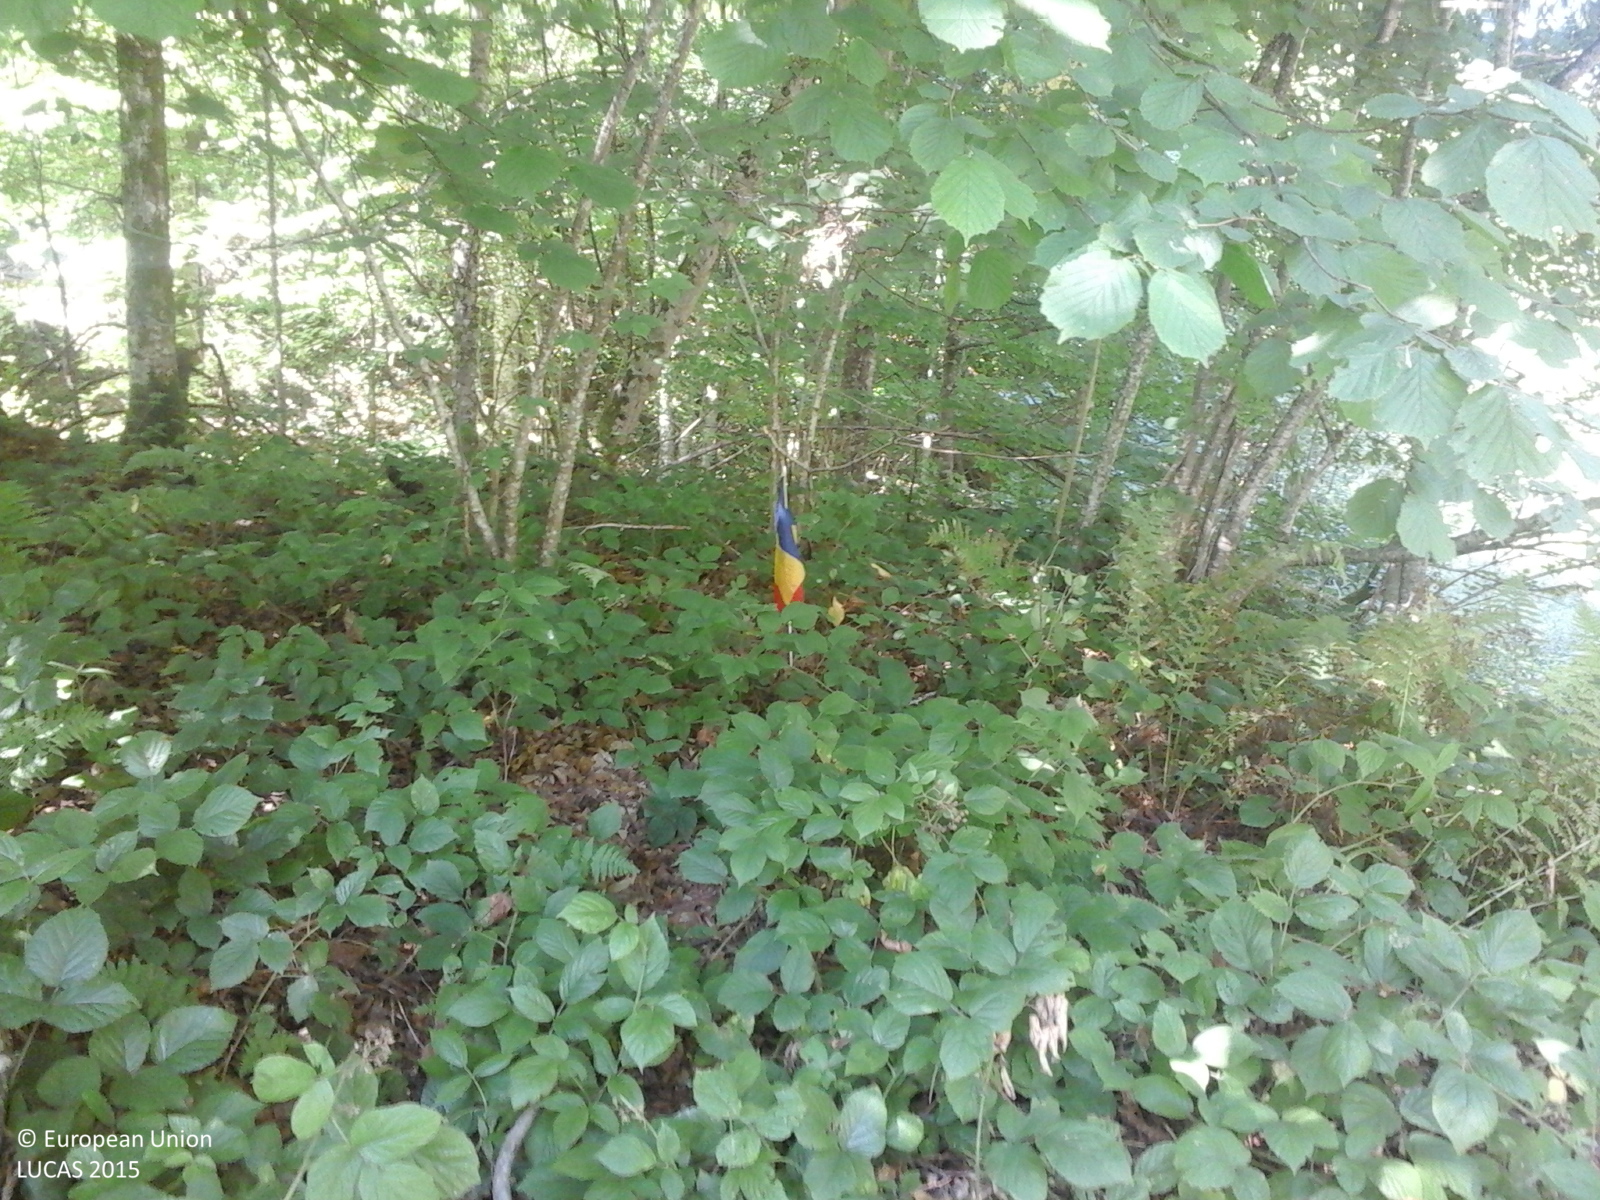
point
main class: Woodland
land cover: Broadleaved woodland
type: non-riverine alder, birch or aspen forest
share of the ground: > 75 %
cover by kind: broadleaved forest trees 100 %
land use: Forestry
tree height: > 5 m
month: August
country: RO
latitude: 46.4724
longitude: 22.3301
